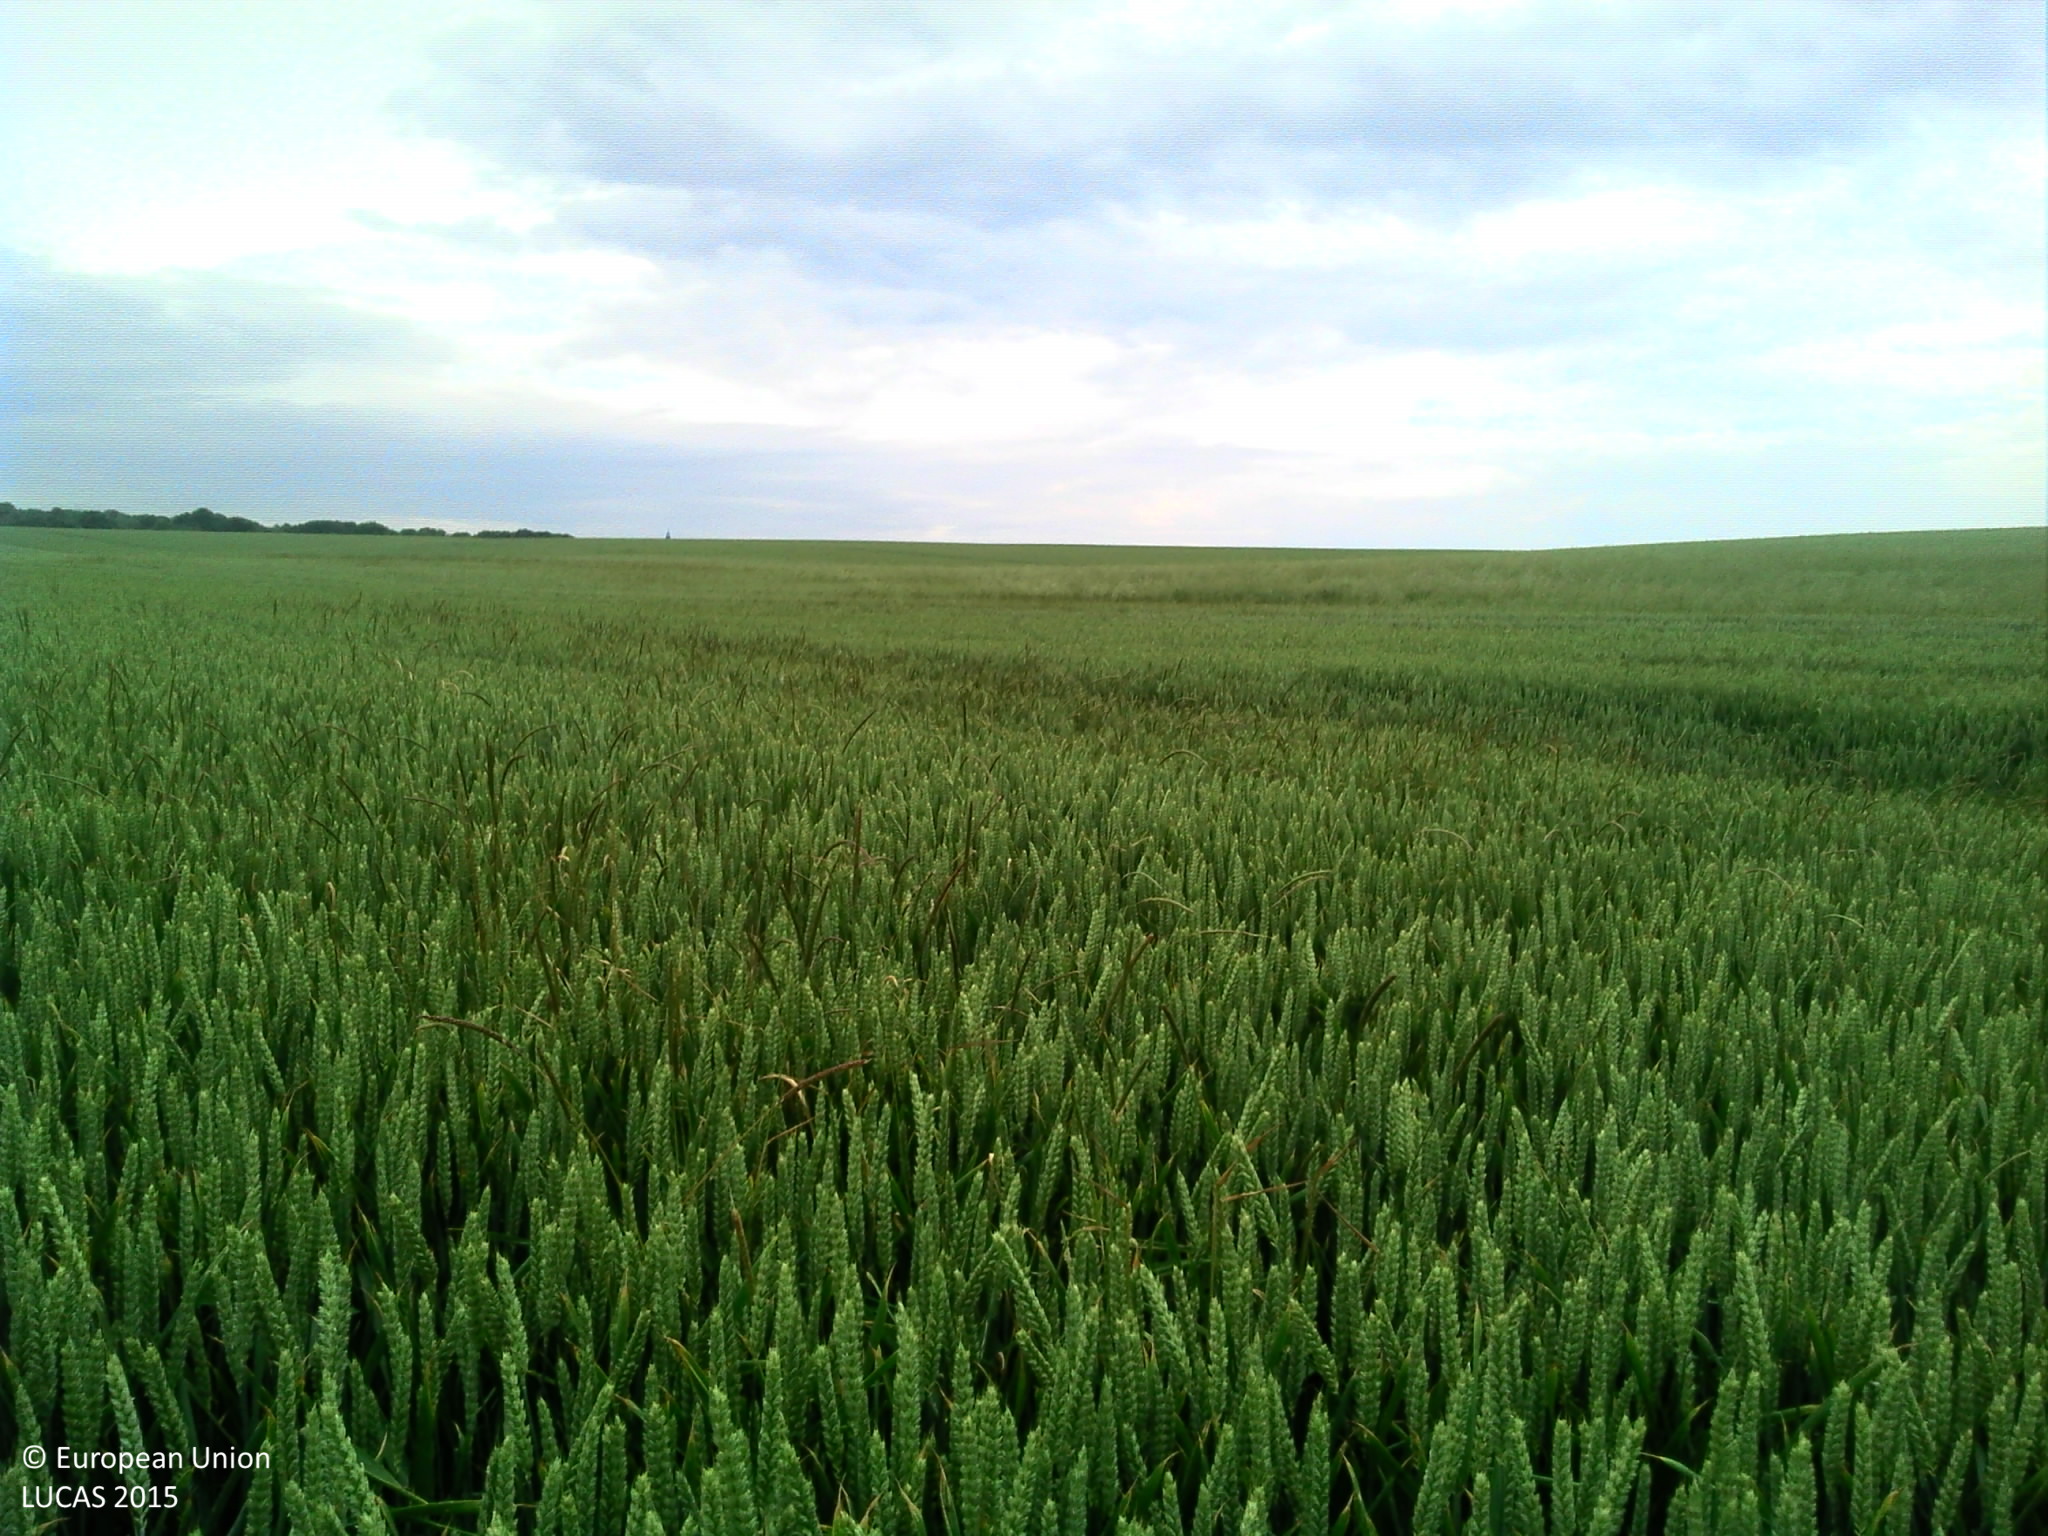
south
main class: Cropland
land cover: Common wheat
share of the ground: > 75 %
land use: Agriculture (excluding fallow land and kitchen gardens)
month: June
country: FR
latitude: 48.3572
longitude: 4.8834
